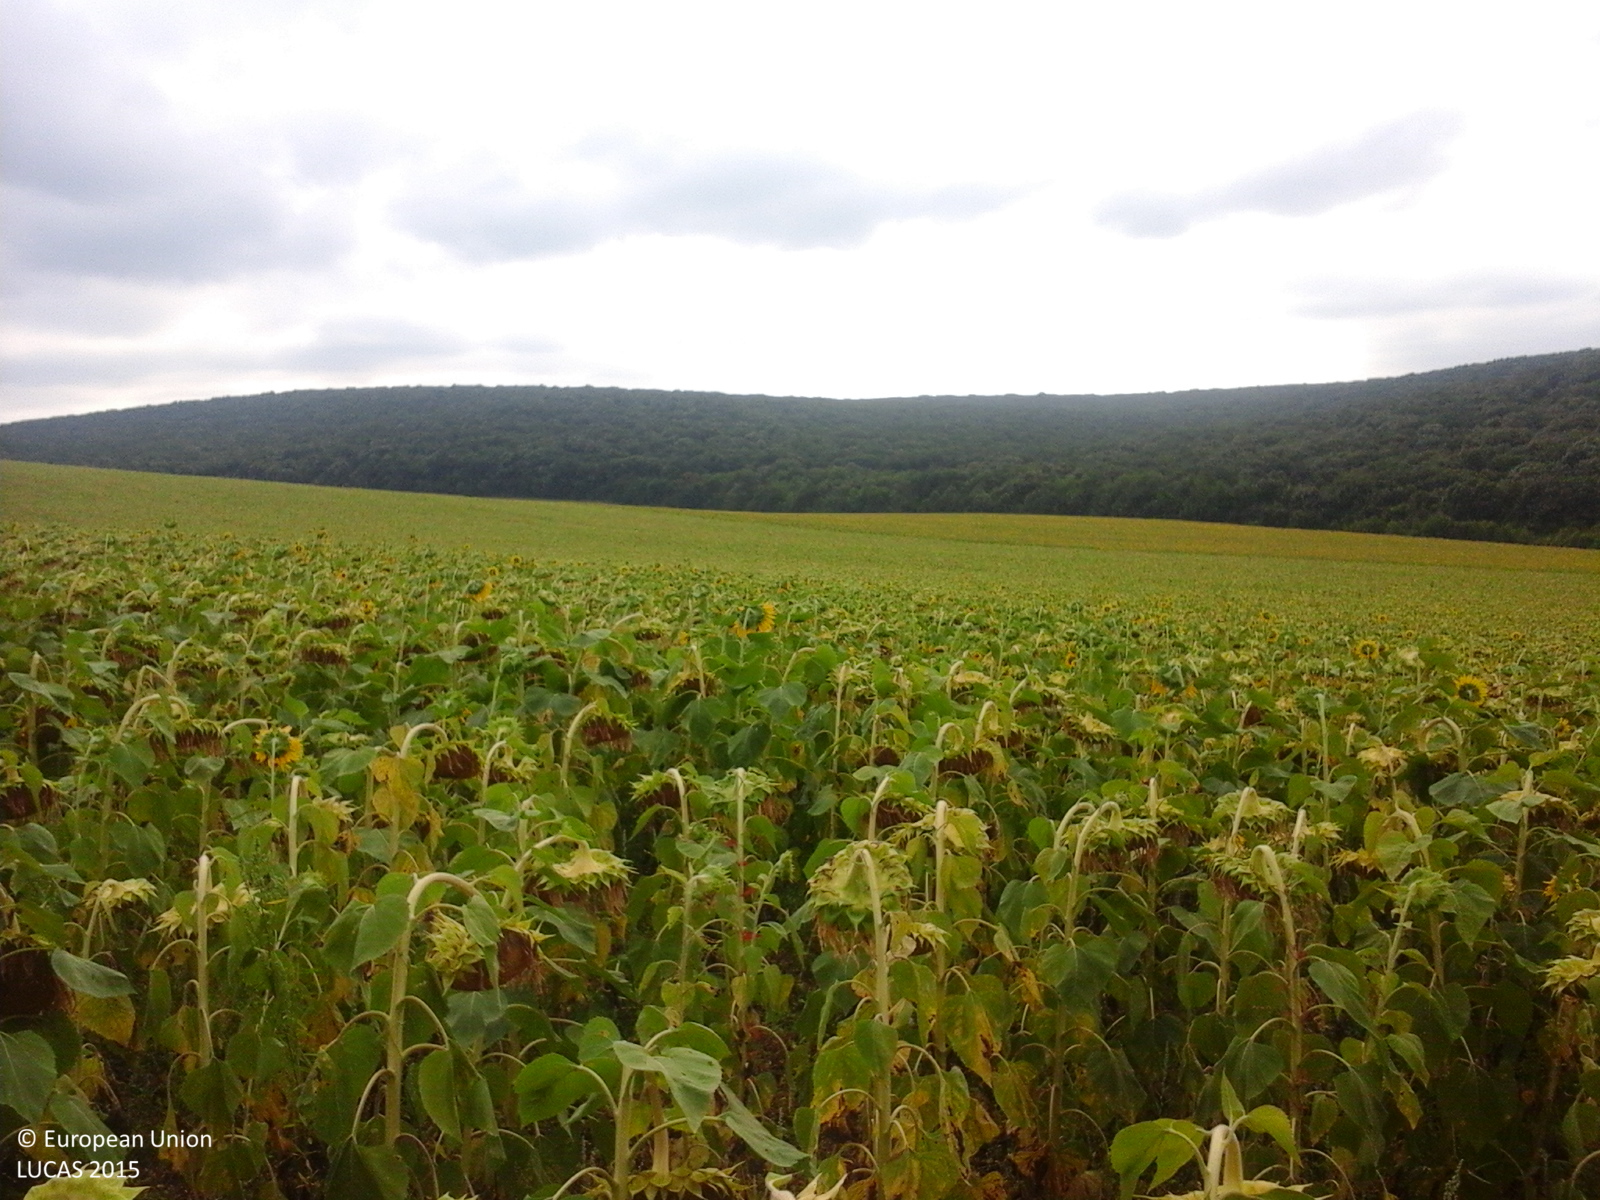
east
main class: Cropland
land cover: Sunflower
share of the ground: > 75 %
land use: Agriculture (excluding fallow land and kitchen gardens)
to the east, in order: Sunflower
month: August
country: RO
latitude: 44.8587
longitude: 28.6462
